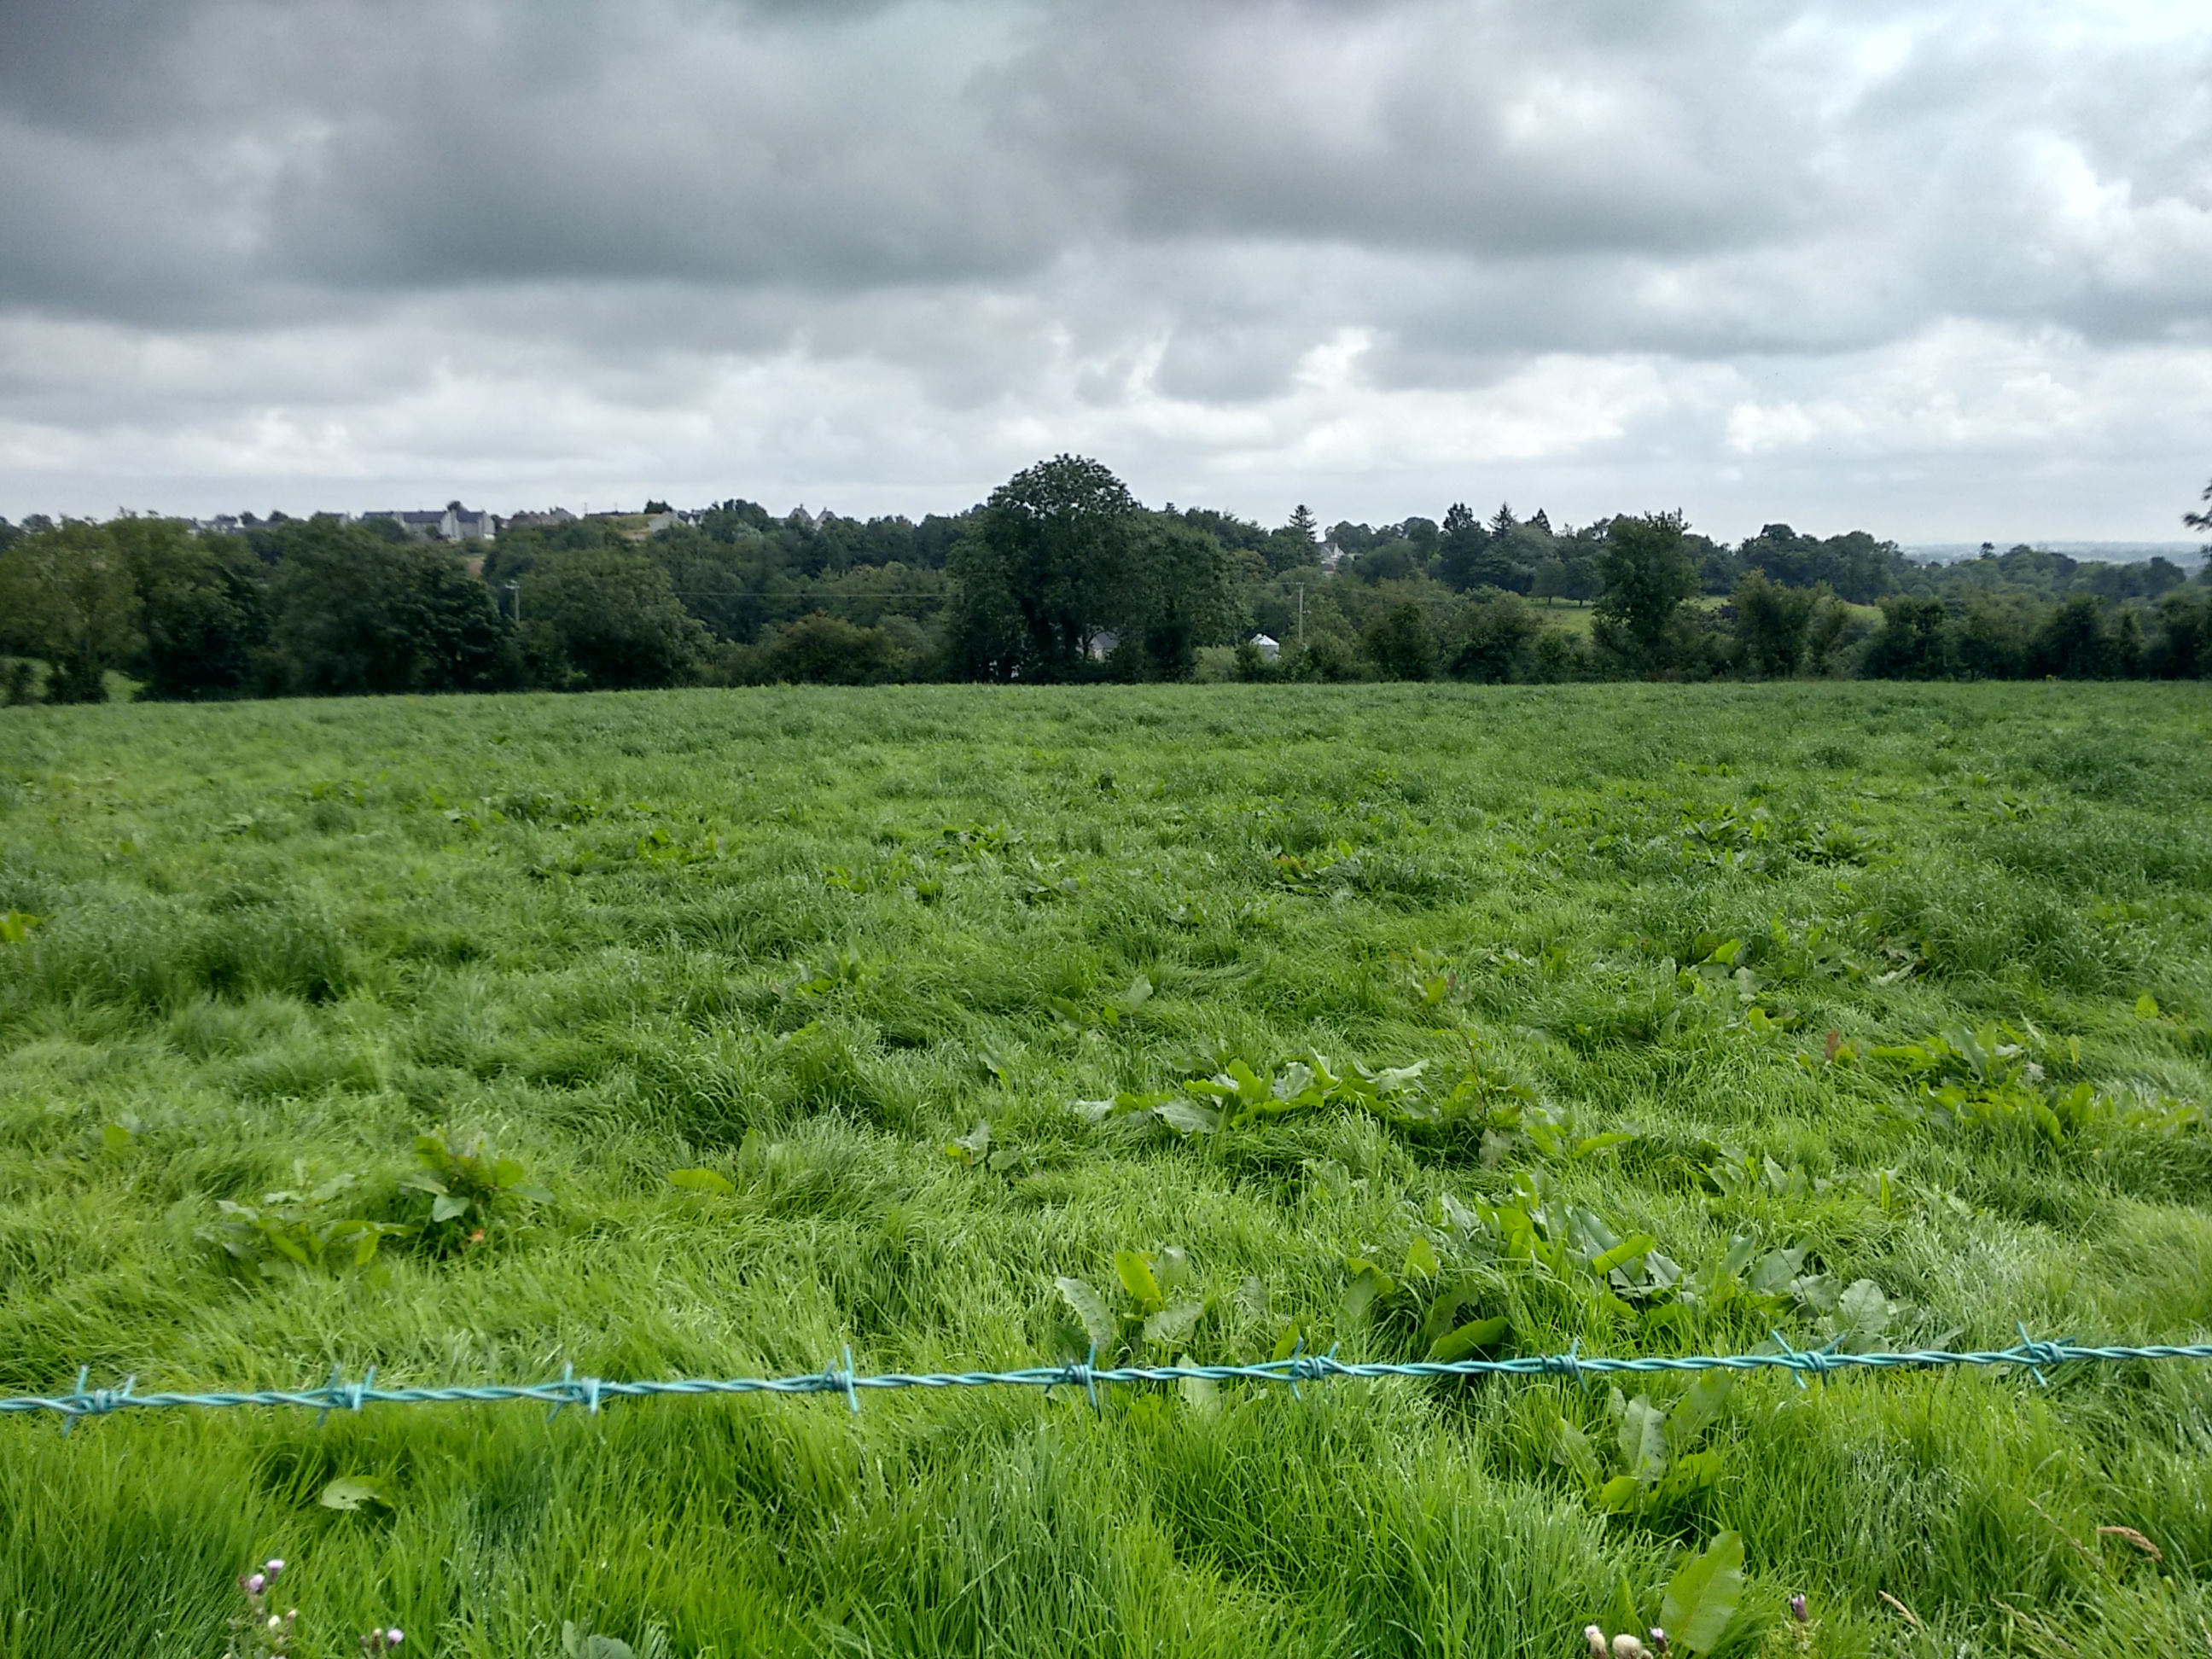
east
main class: Grassland
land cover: Grassland without tree/shrub cover
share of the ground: > 75 %
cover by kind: herbaceous plants 100 %
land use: Agriculture (excluding fallow land and kitchen gardens)
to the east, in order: Grassland without tree/shrub cover; Abandoned hedges; Fences; Grassland without tree/shrub cover; Electric lines; Grassland without tree/shrub cover; Electric lines; Grassland without tree/shrub cover
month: August
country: GB
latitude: 54.4109
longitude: -6.7574
